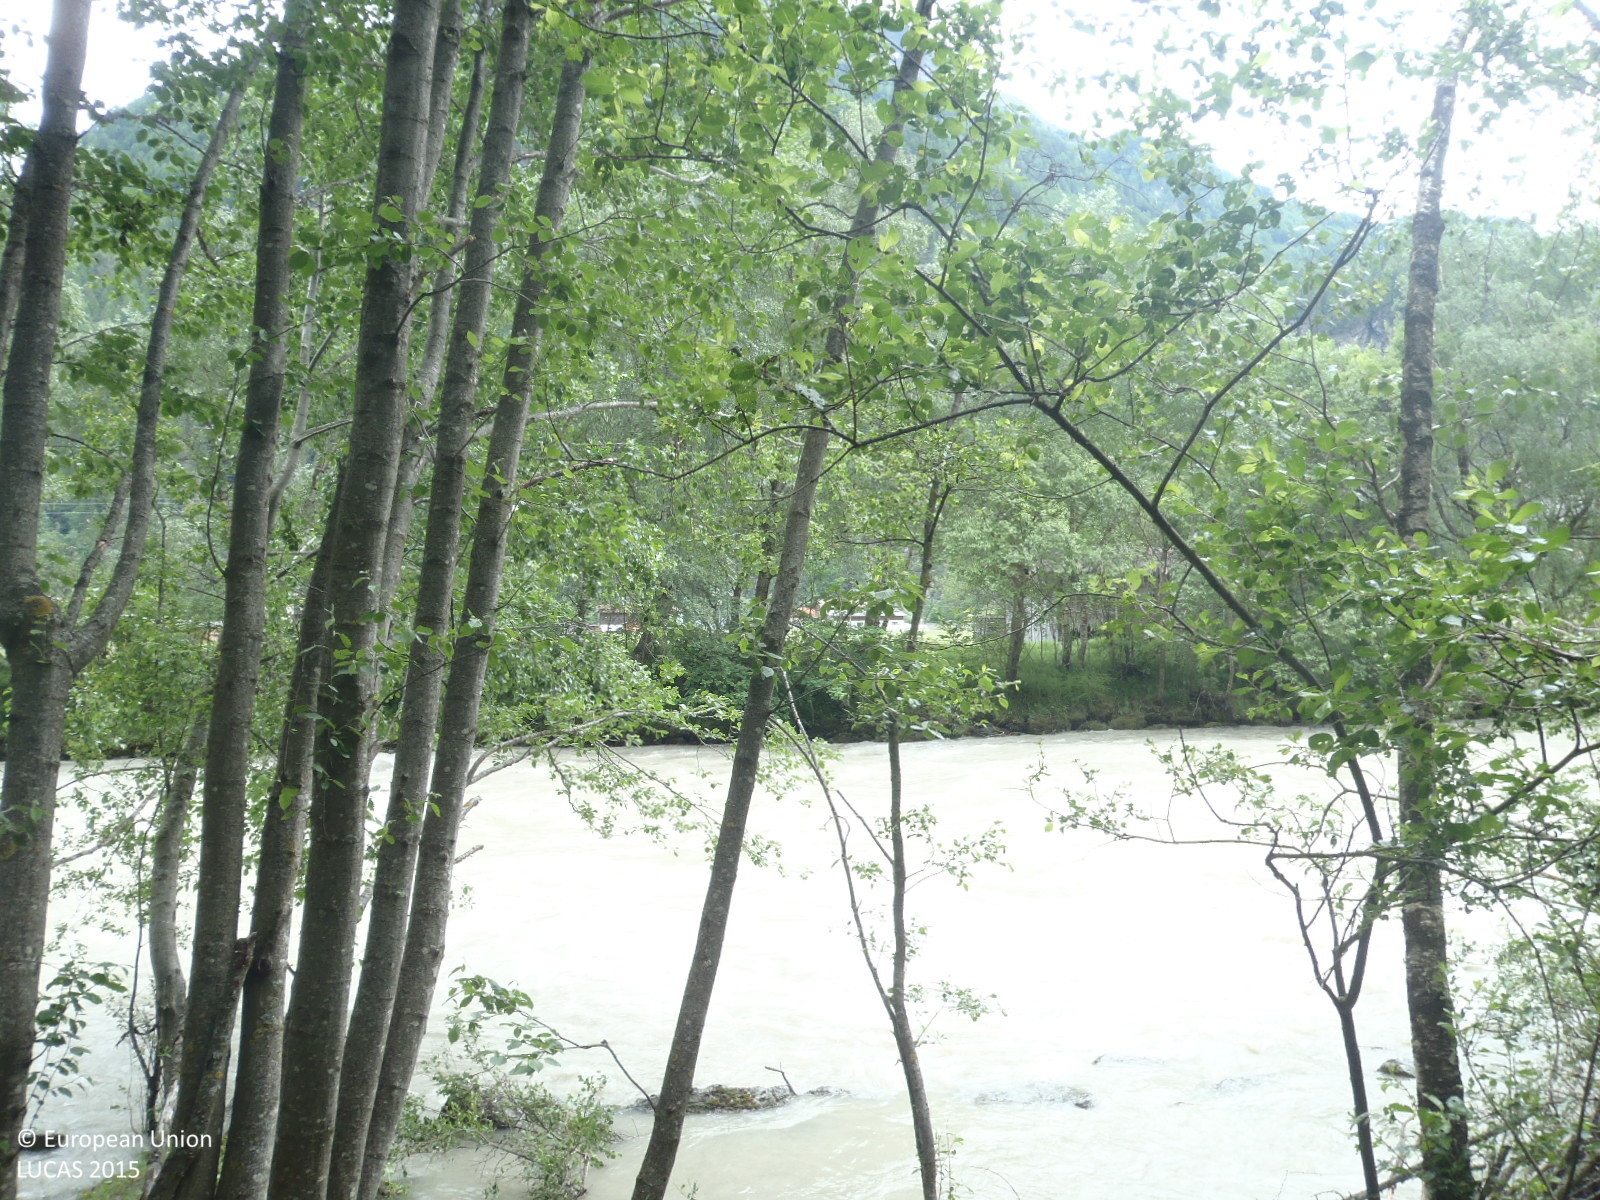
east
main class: Woodland
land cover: Pine dominated coniferous woodland
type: alpine coniferous forest
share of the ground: > 75 %
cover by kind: coniferous forest trees 85 %, shrubs 10 %, consolidated bare surface 5 %
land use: Semi-natural and natural areas not in use
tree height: > 5 m
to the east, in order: Pine dominated coniferous woodland; Other coniferous woodland; Tracks; Inland fresh running water; Broadleaved woodland; Tracks; Grassland without tree/shrub cover; Electric lines; Grassland without tree/shrub cover
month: June
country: AT
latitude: 47.0673
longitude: 10.9603
